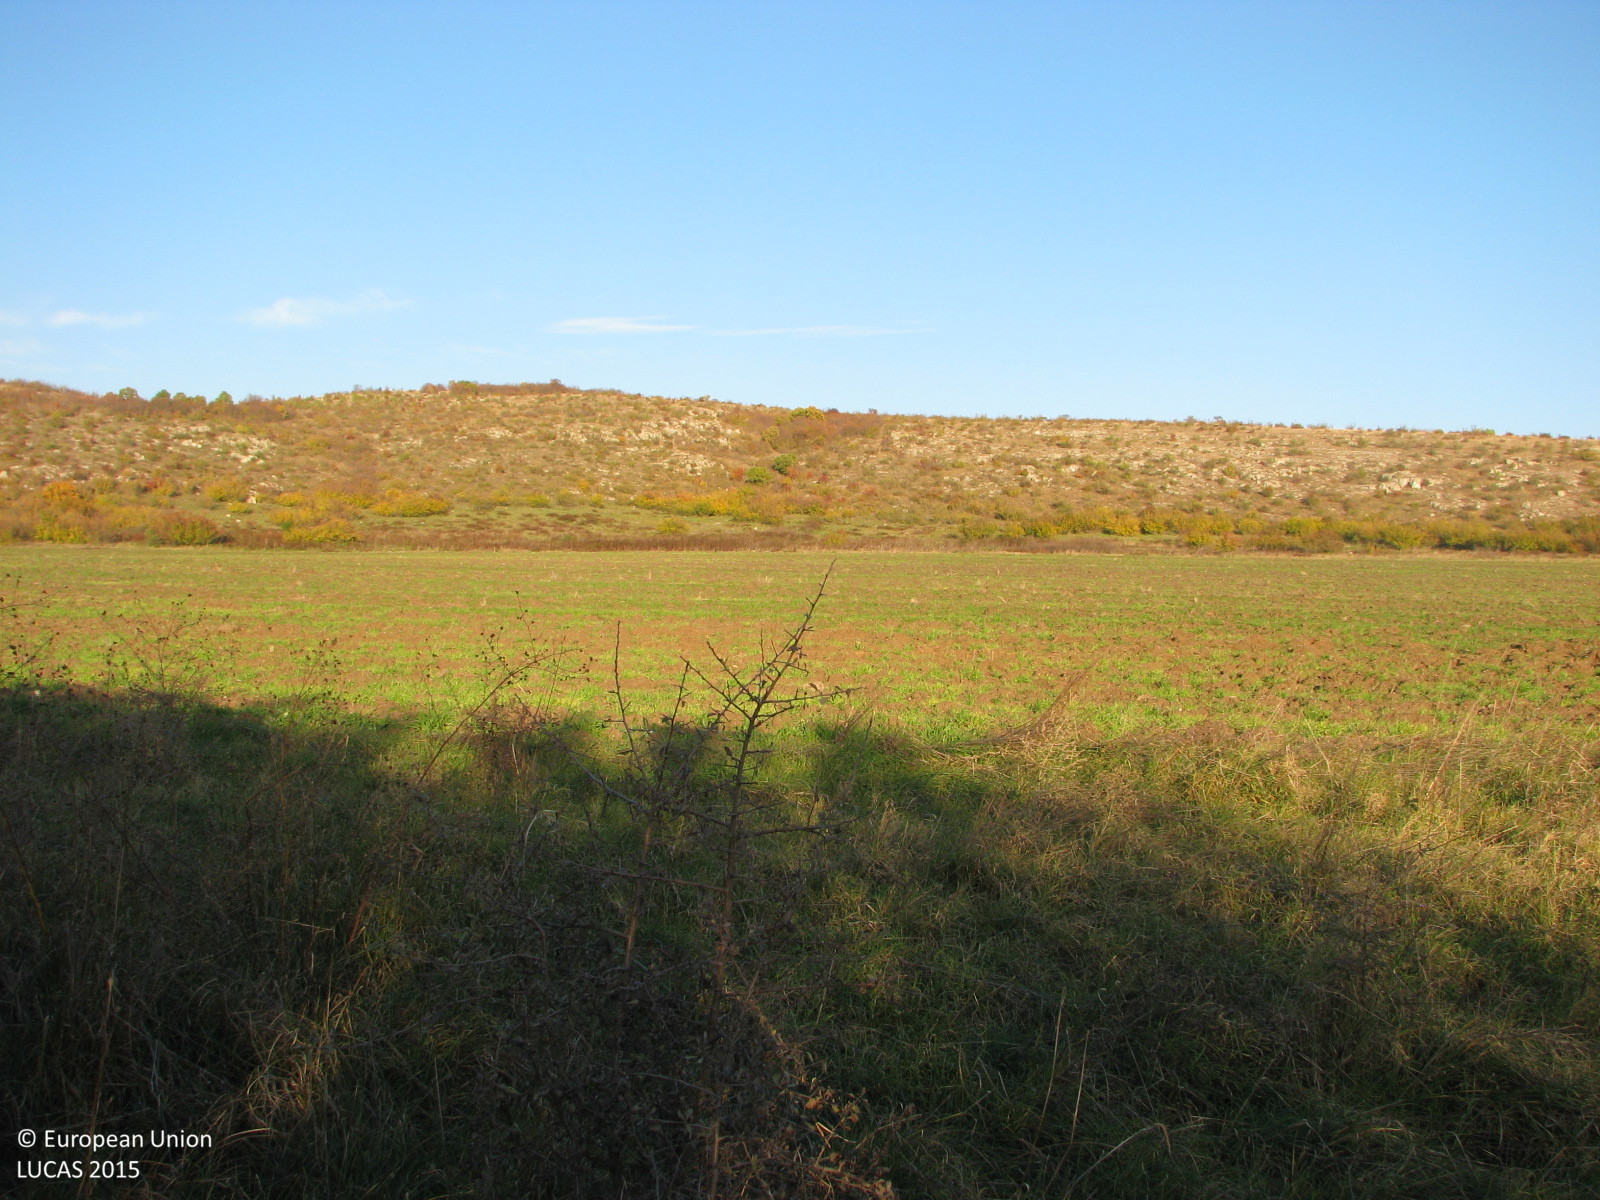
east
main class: Grassland
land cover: Grassland with sparse tree/shrub cover
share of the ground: > 75 %
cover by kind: herbaceous plants 90 %, broadleaved forest trees 5 %, shrubs 5 %
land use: Semi-natural and natural areas not in use
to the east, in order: Grassland with sparse tree/shrub cover; Other bare soil; Ditches and canals; Tracks; Grassland with sparse tree/shrub cover
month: November
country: BG
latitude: 41.8460
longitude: 26.4746
